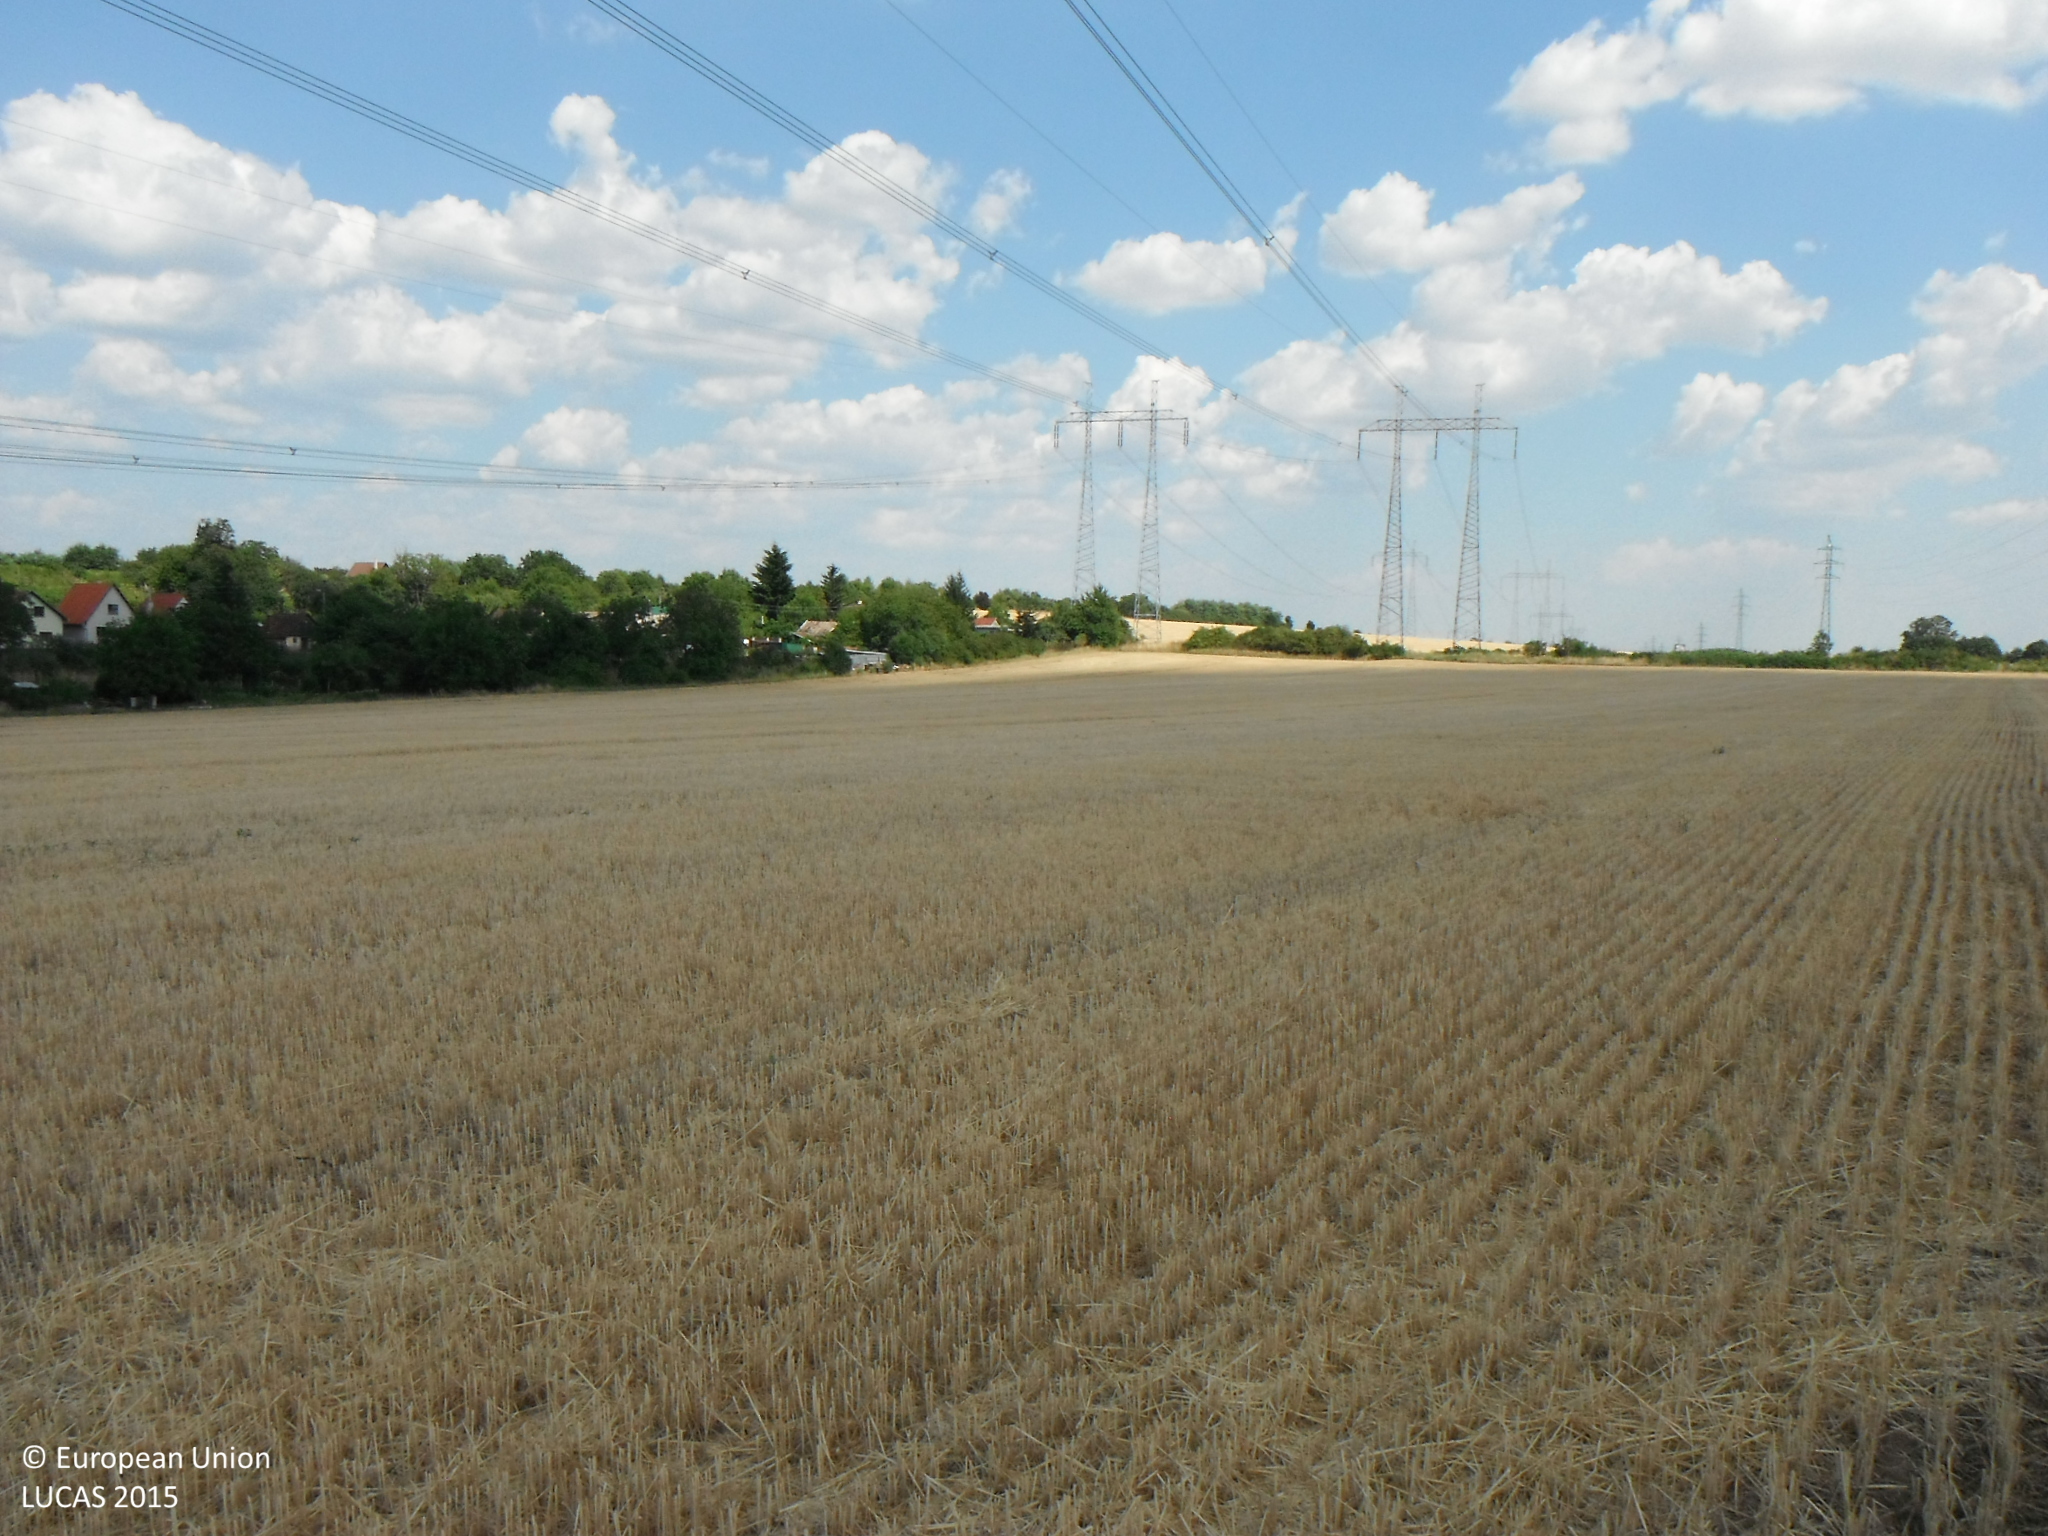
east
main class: Cropland
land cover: Common wheat
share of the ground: > 75 %
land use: Agriculture (excluding fallow land and kitchen gardens)
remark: Harvested field
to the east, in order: Common wheat; Electric lines; Common wheat; Electric lines; Common wheat; Shrubland with sparse tree cover; Artificial constructions in urban areas
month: July
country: SK
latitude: 48.2293
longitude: 18.6194
